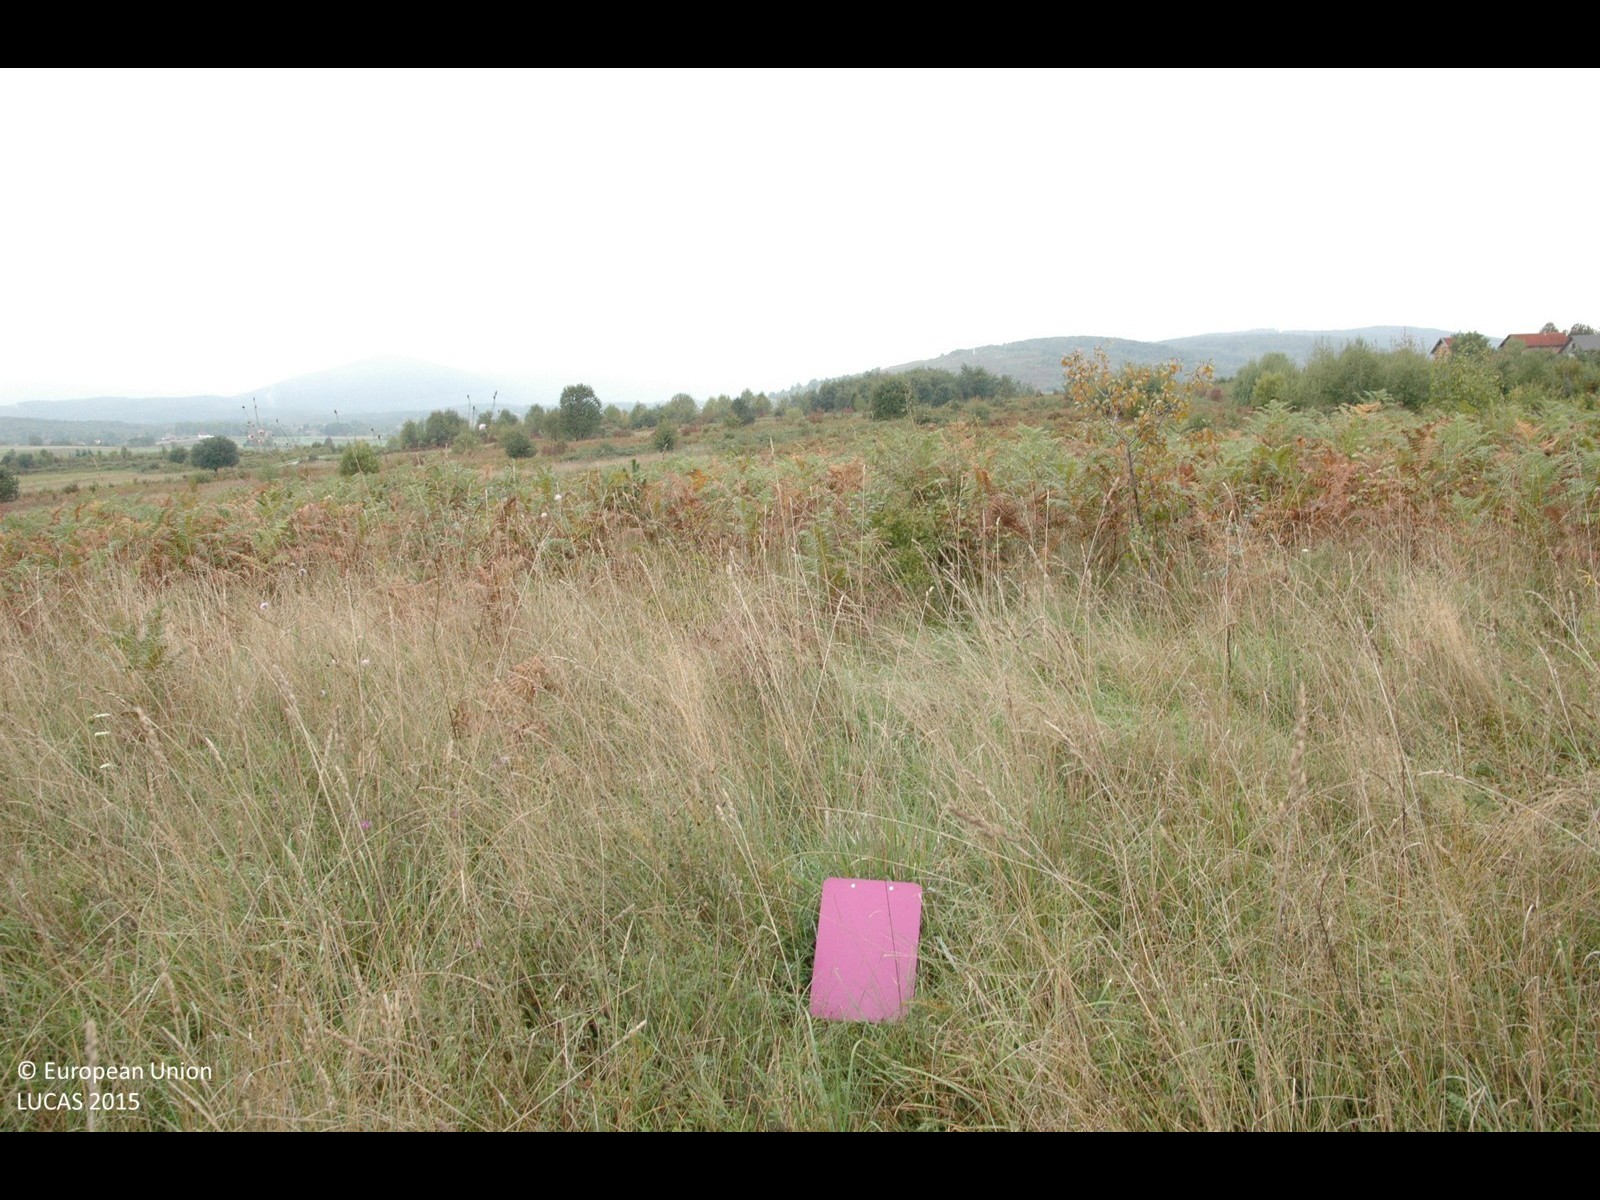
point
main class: Grassland
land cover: Grassland without tree/shrub cover
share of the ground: > 75 %
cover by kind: herbaceous plants 100 %
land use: Semi-natural and natural areas not in use
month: September
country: HR
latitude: 44.9910
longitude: 15.6647
